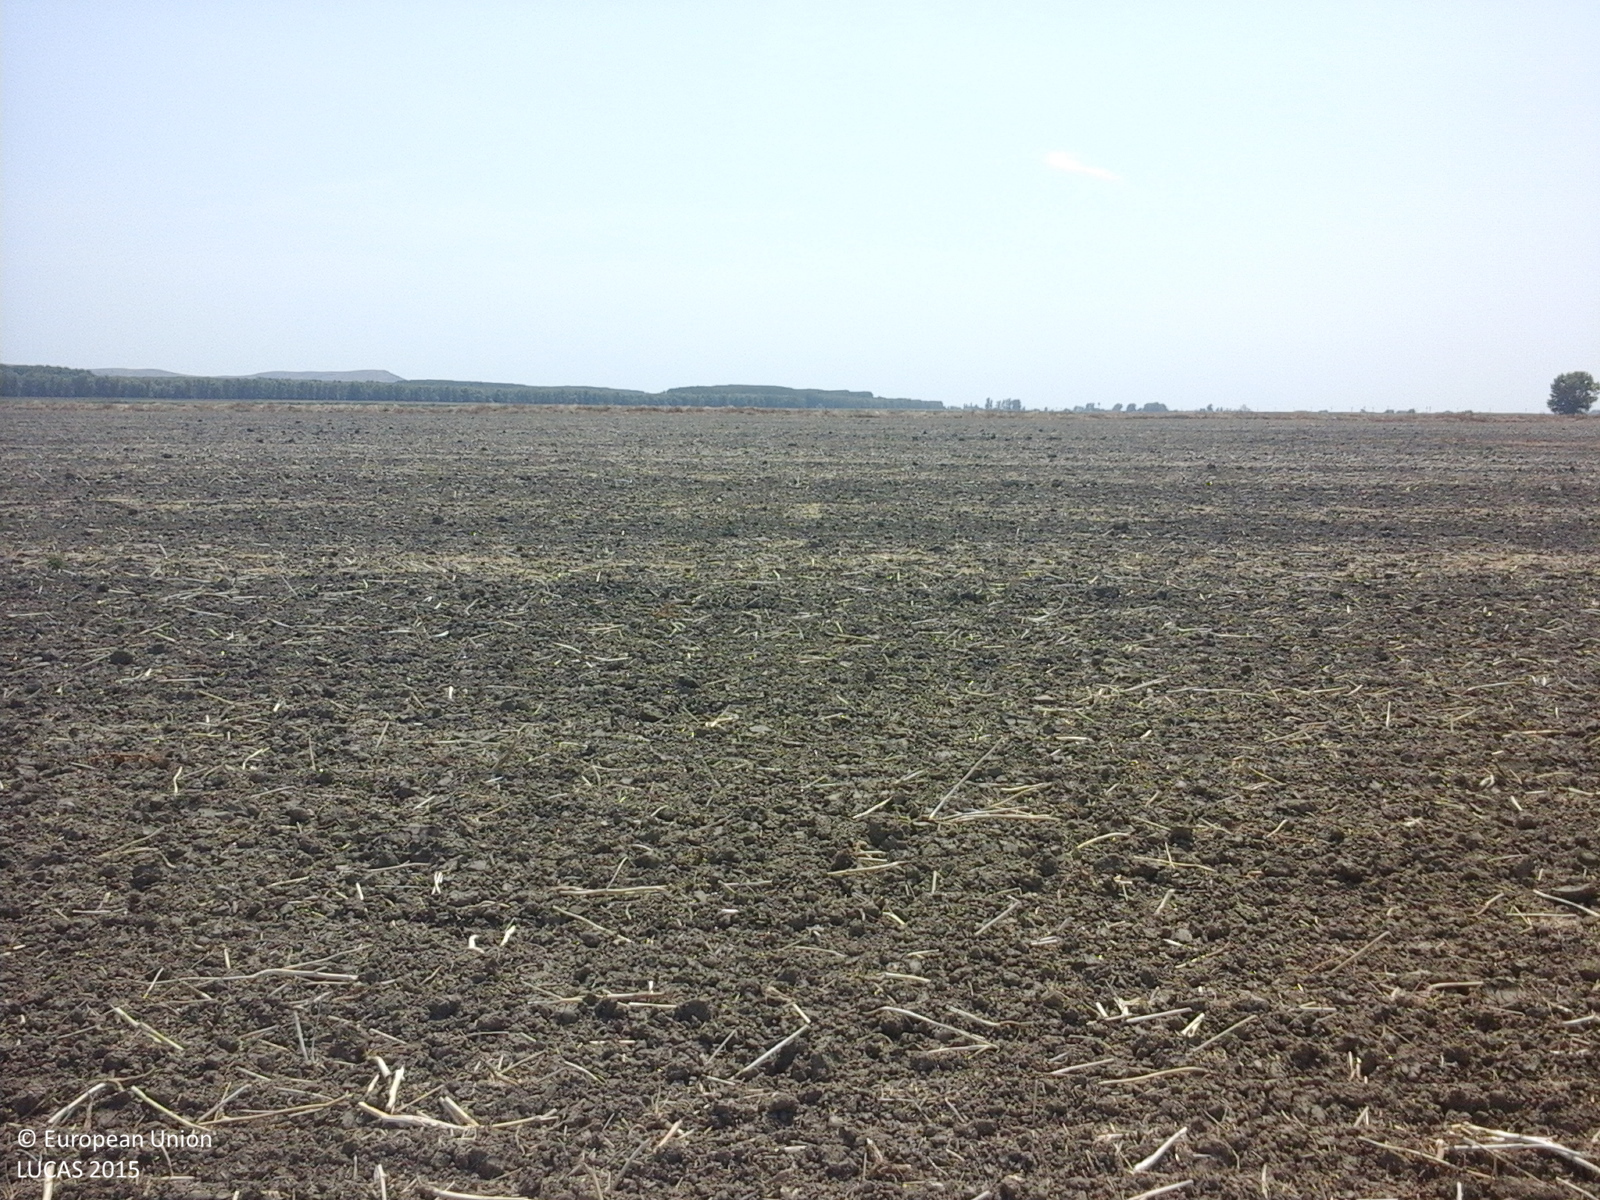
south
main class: Cropland
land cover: Rape and turnip rape
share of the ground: 10 - 25 %
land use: Agriculture (excluding fallow land and kitchen gardens)
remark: Harvested field
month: August
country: RO
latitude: 45.0428
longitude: 28.1320
